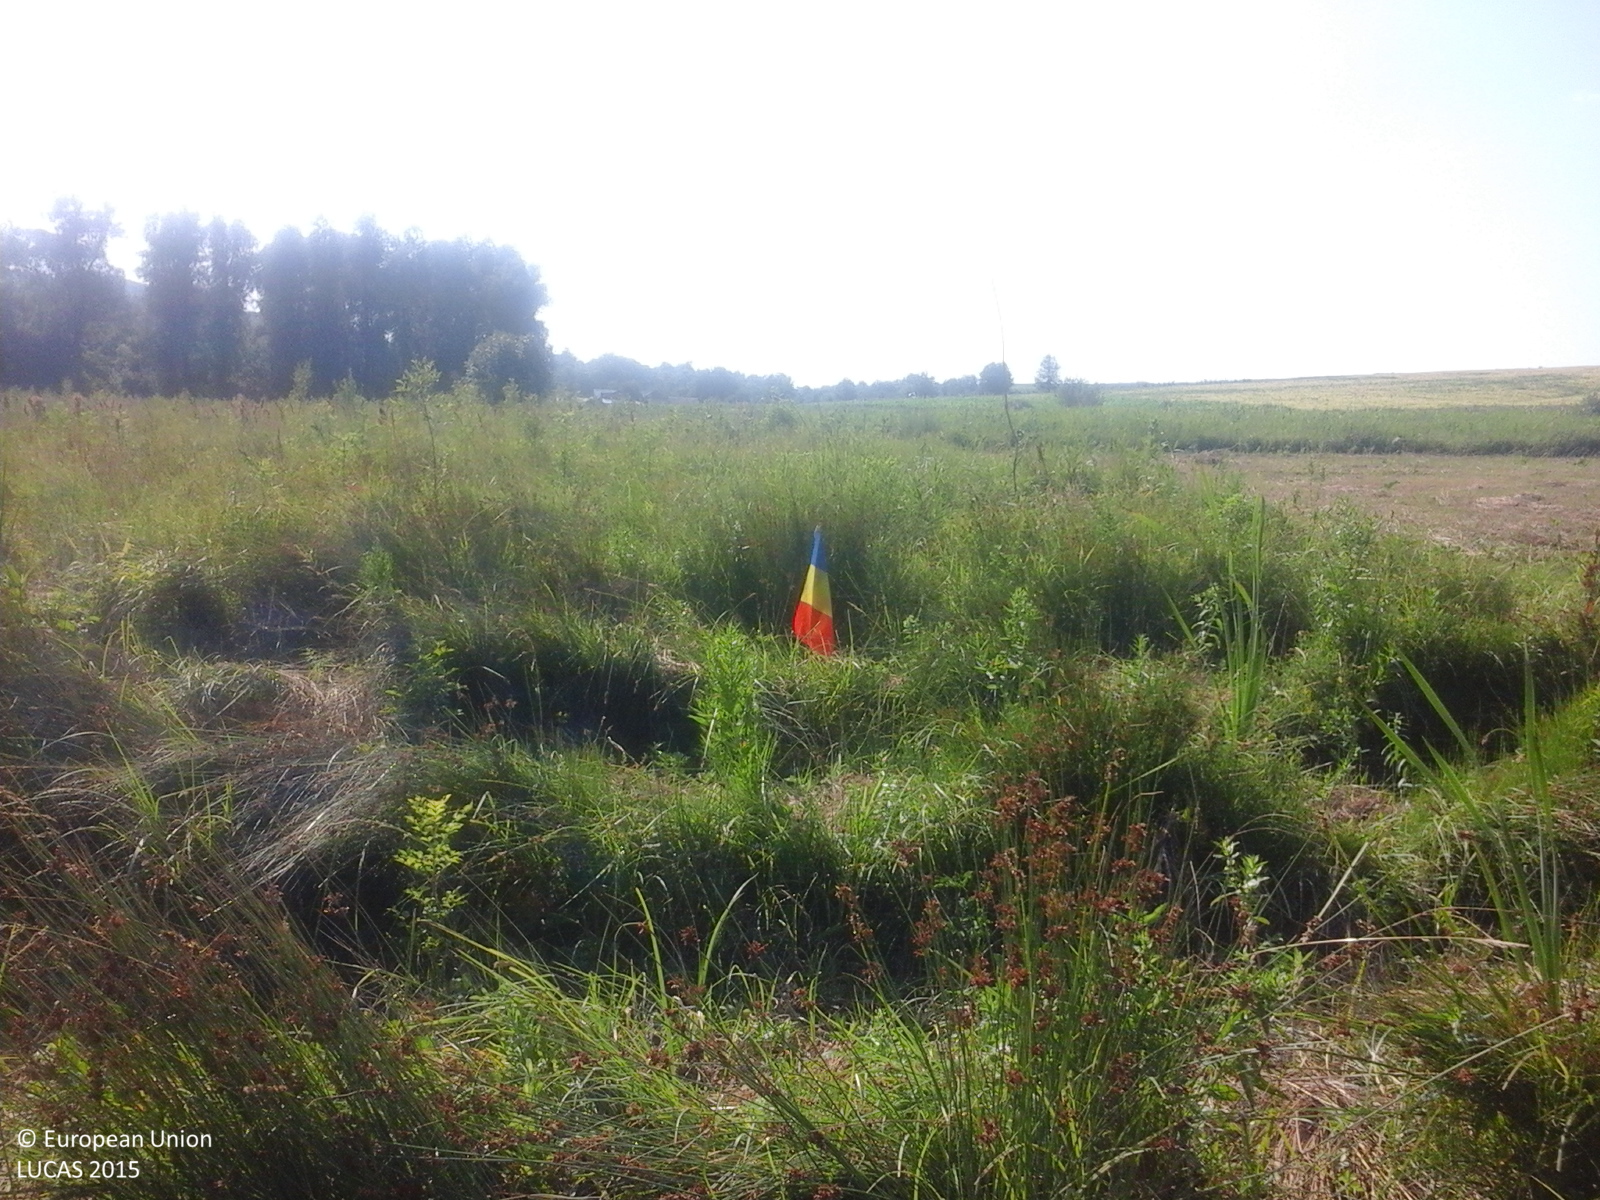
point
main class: Grassland
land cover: Grassland without tree/shrub cover
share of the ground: > 75 %
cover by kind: herbaceous plants 95 %, shrubs 5 %
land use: Agriculture (excluding fallow land and kitchen gardens)
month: June
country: RO
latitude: 46.5874
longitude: 27.7244
